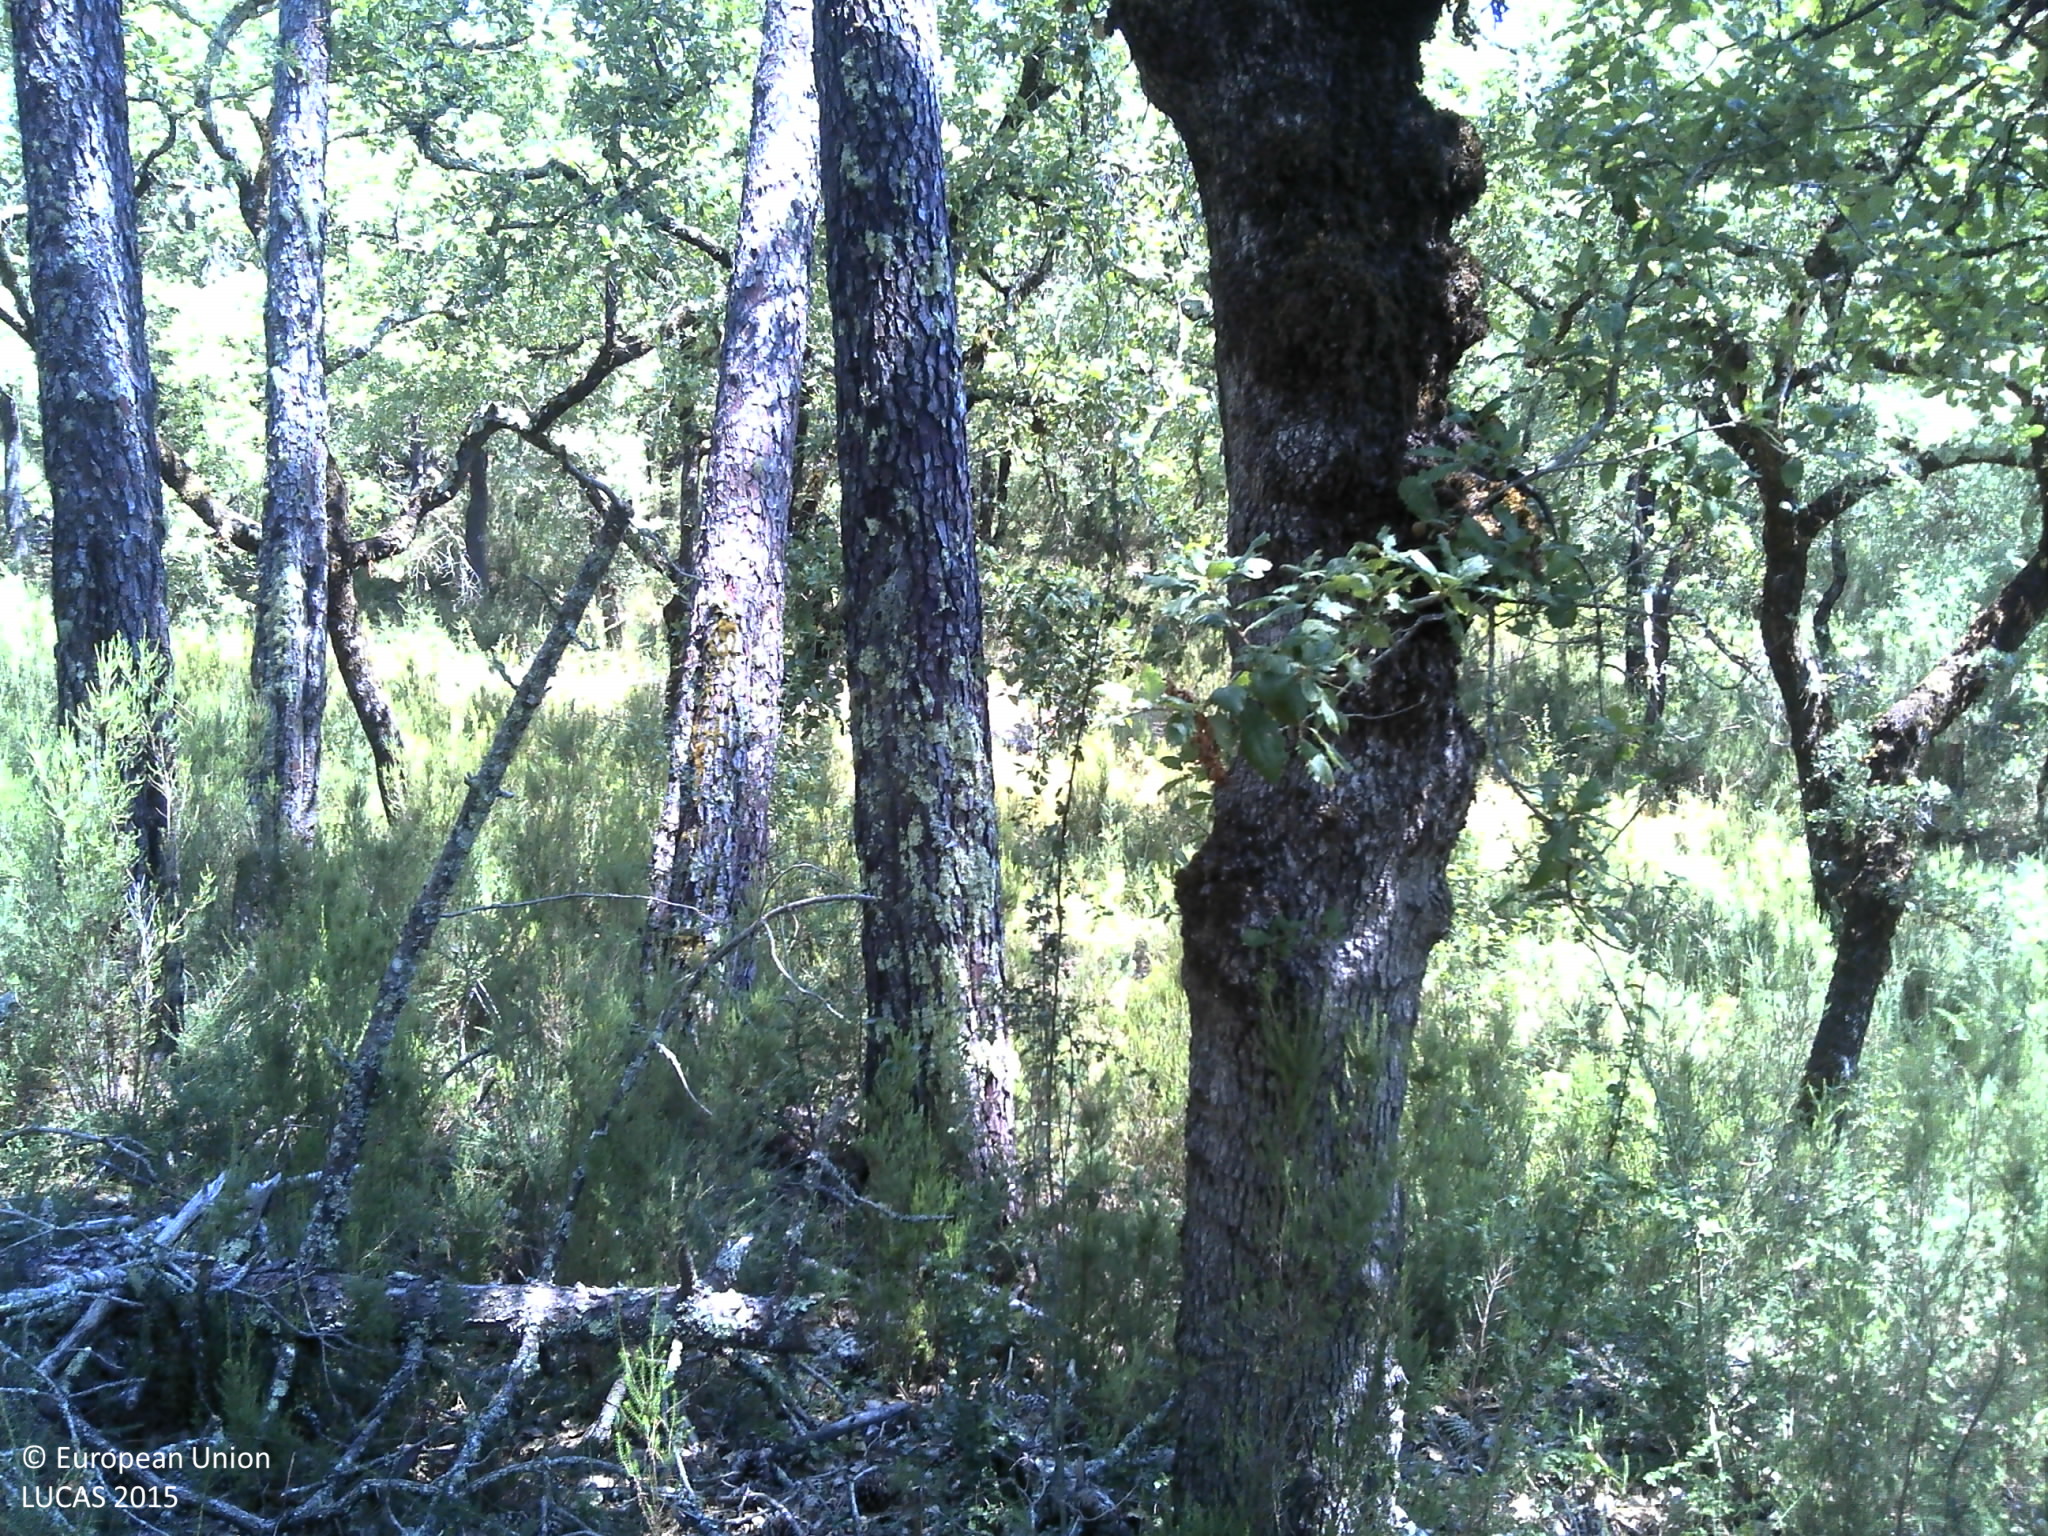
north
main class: Woodland
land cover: Broadleaved woodland
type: thermophilous deciduous forest
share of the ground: 25 - 50 %
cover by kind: broadleaved forest trees 50 %, shrubs 30 %, unconsolidated bare surface 20 %
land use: Forestry
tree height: > 5 m
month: July
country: PT
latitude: 39.9928
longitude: -8.4808
